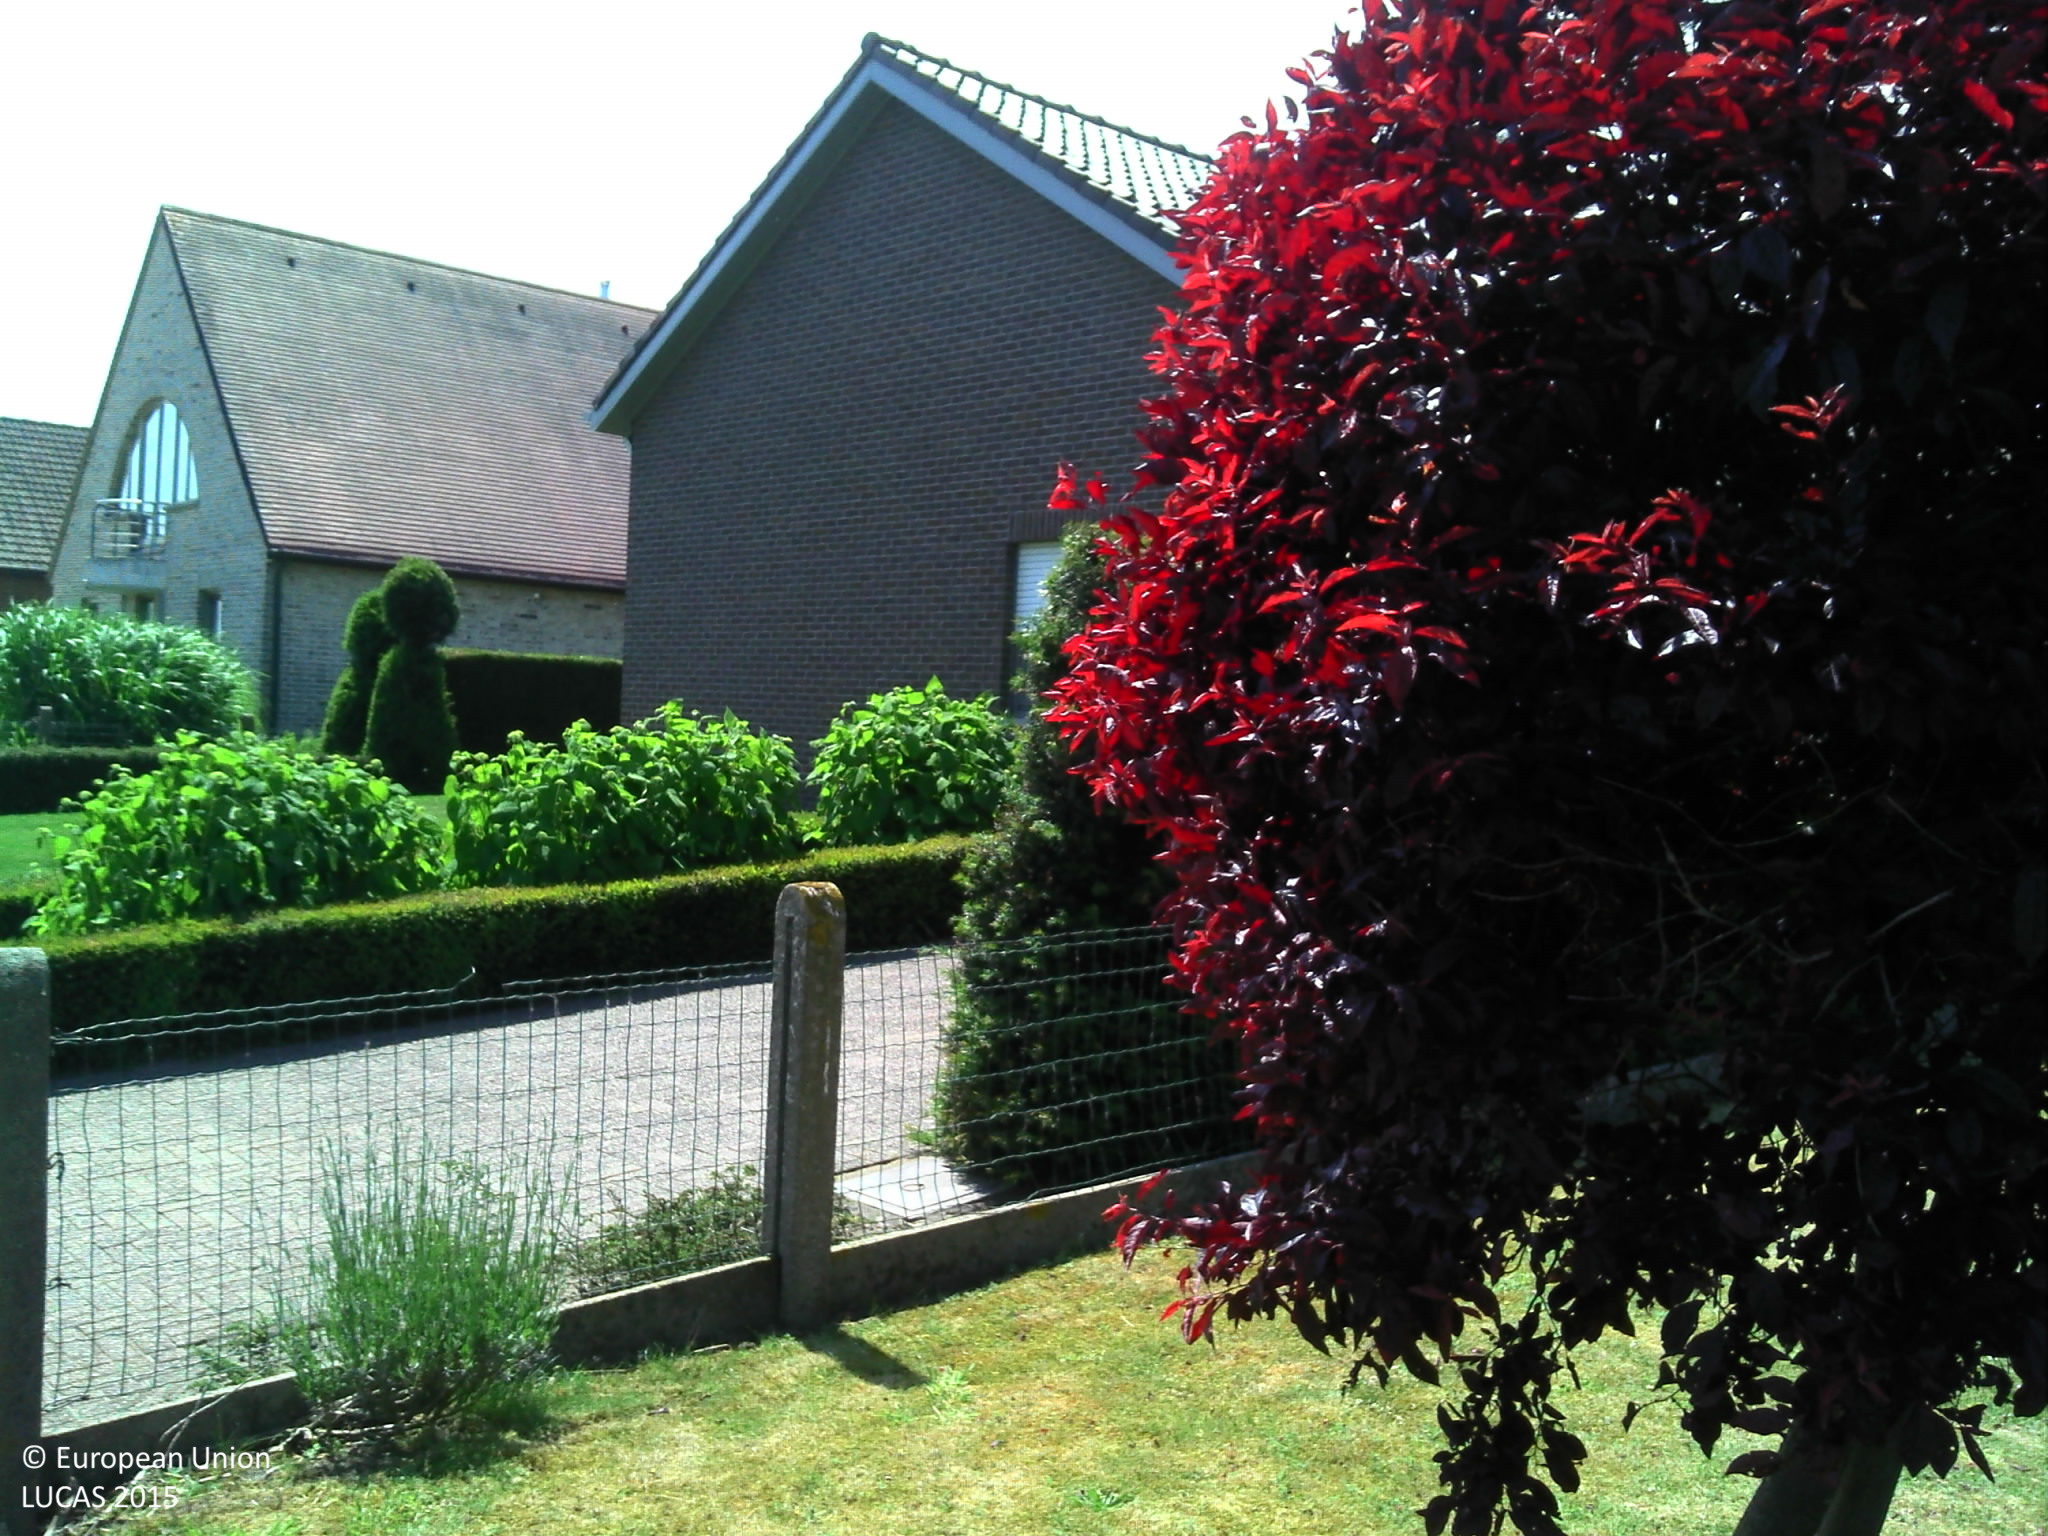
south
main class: Grassland
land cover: Grassland with sparse tree/shrub cover
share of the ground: > 75 %
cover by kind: herbaceous plants 95 %, broadleaved forest trees 5 %
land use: Residential
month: June
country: BE
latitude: 51.0592
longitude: 4.1018
